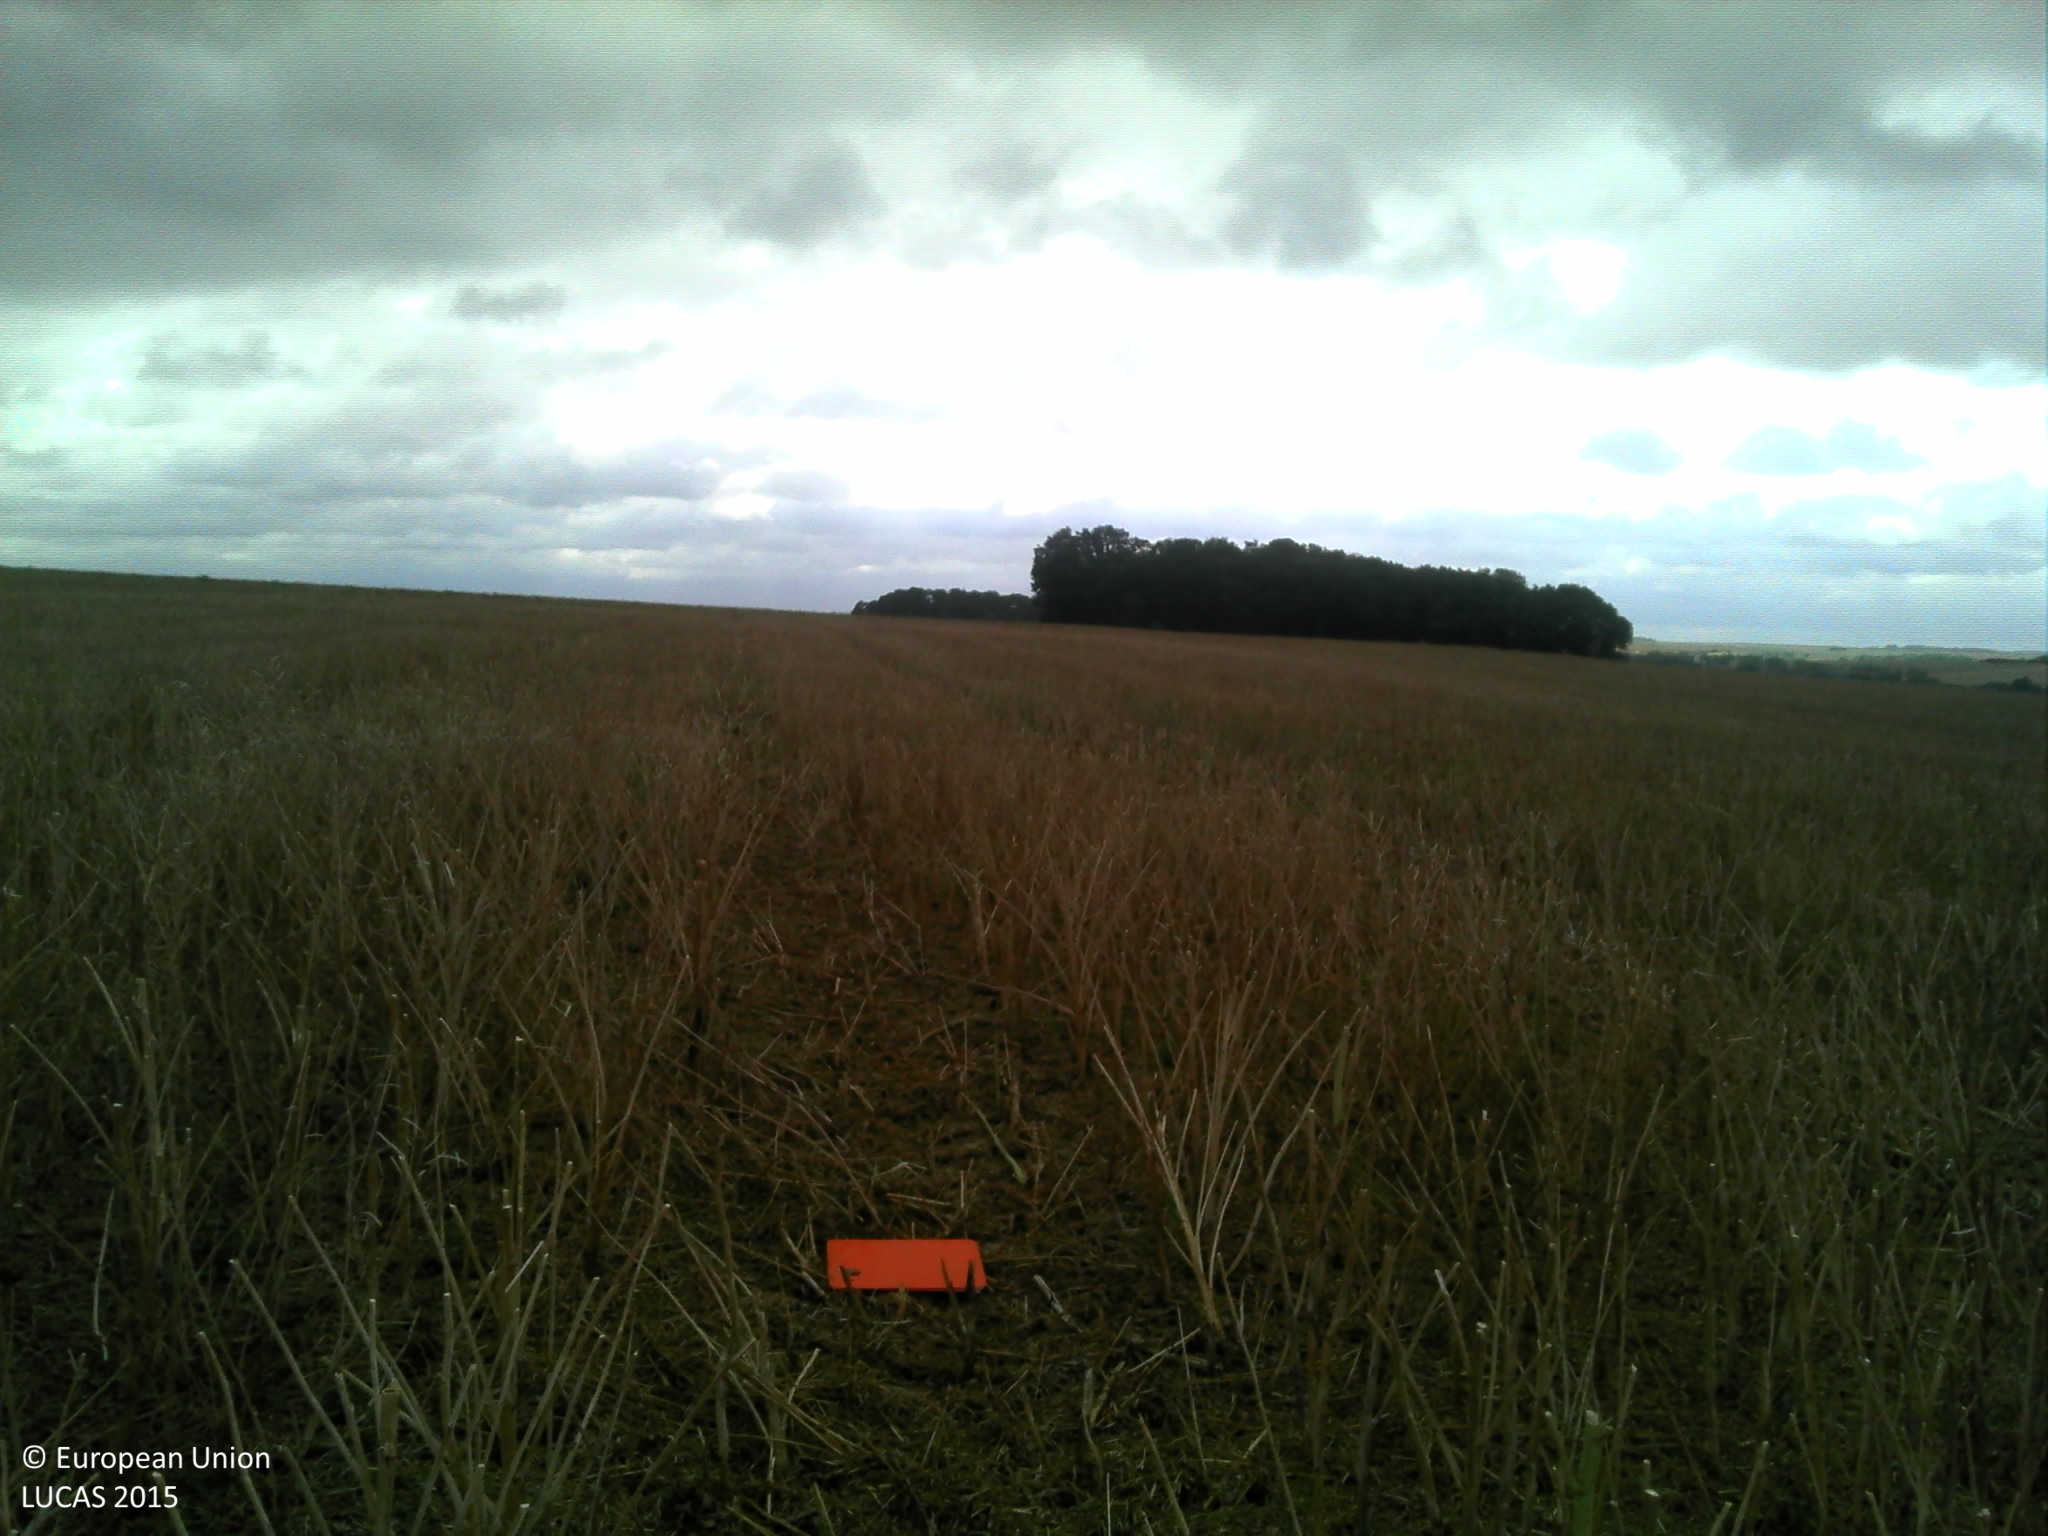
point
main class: Cropland
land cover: Rape and turnip rape
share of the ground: 25 - 50 %
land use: Agriculture (excluding fallow land and kitchen gardens)
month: July
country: FR
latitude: 49.8283
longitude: 2.4948
